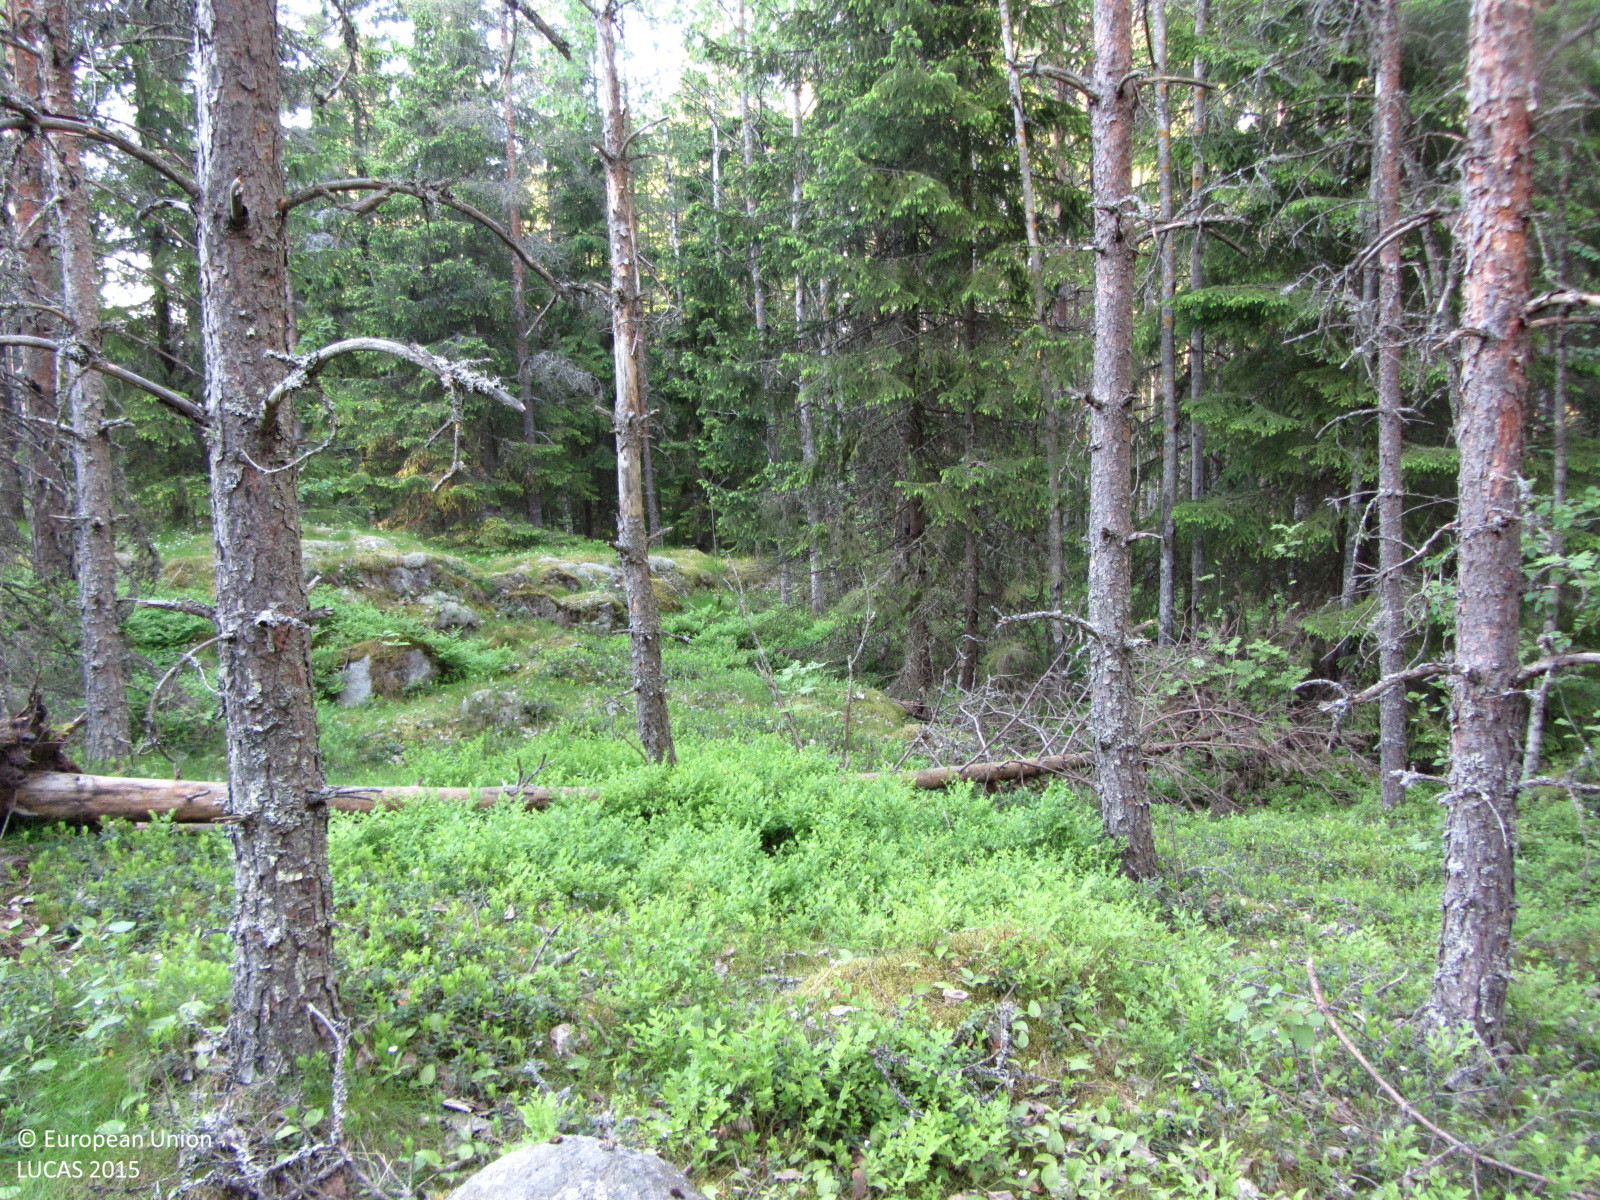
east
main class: Woodland
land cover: Other coniferous woodland
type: boreal forest
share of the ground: 50 - 75 %
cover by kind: coniferous forest trees 50 %, shrubs 30 %, broadleaved forest trees 10 %, lichens and mosses 10 %
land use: Forestry
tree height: > 5 m
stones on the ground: 10 - 25 %
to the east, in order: Other coniferous woodland; Other mixed woodland; Broadleaved woodland; Grassland with sparse tree/shrub cover
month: June
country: FI
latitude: 60.3500
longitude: 24.2555
